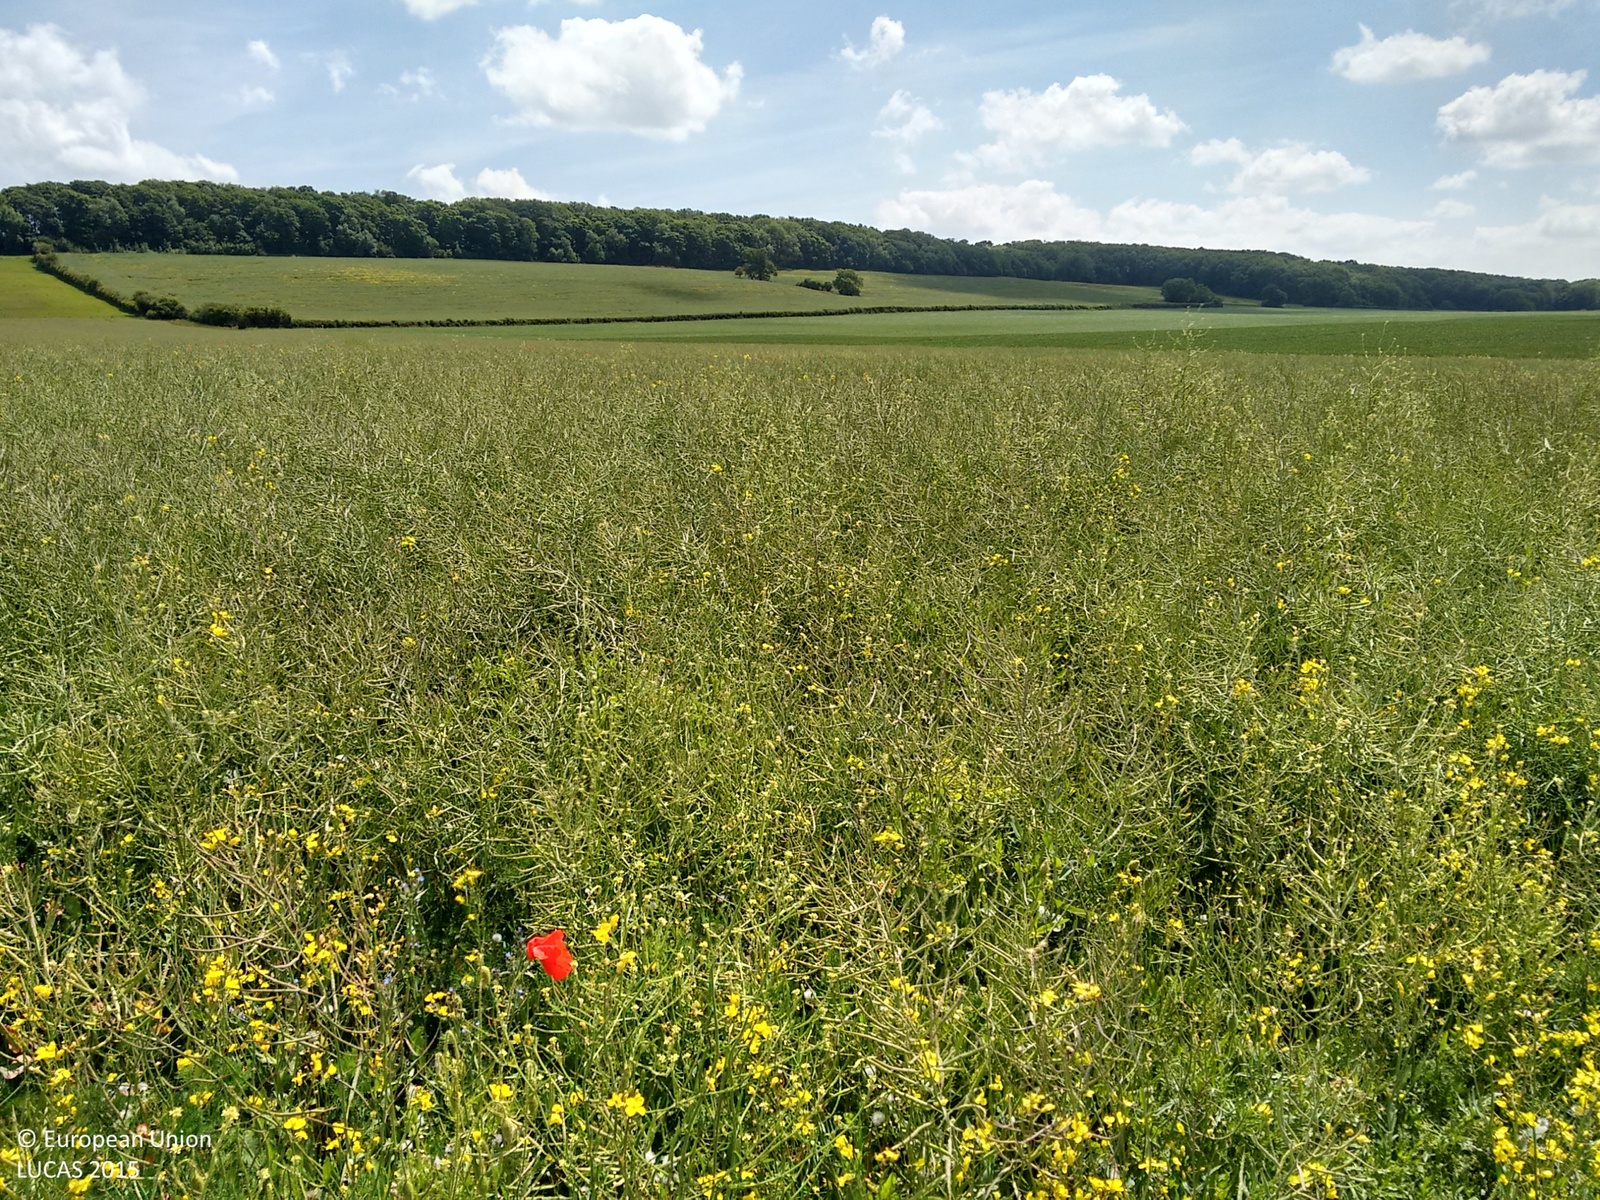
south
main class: Cropland
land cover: Rape and turnip rape
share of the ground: > 75 %
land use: Agriculture (excluding fallow land and kitchen gardens)
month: June
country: GB
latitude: 52.9719
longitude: -0.5966
